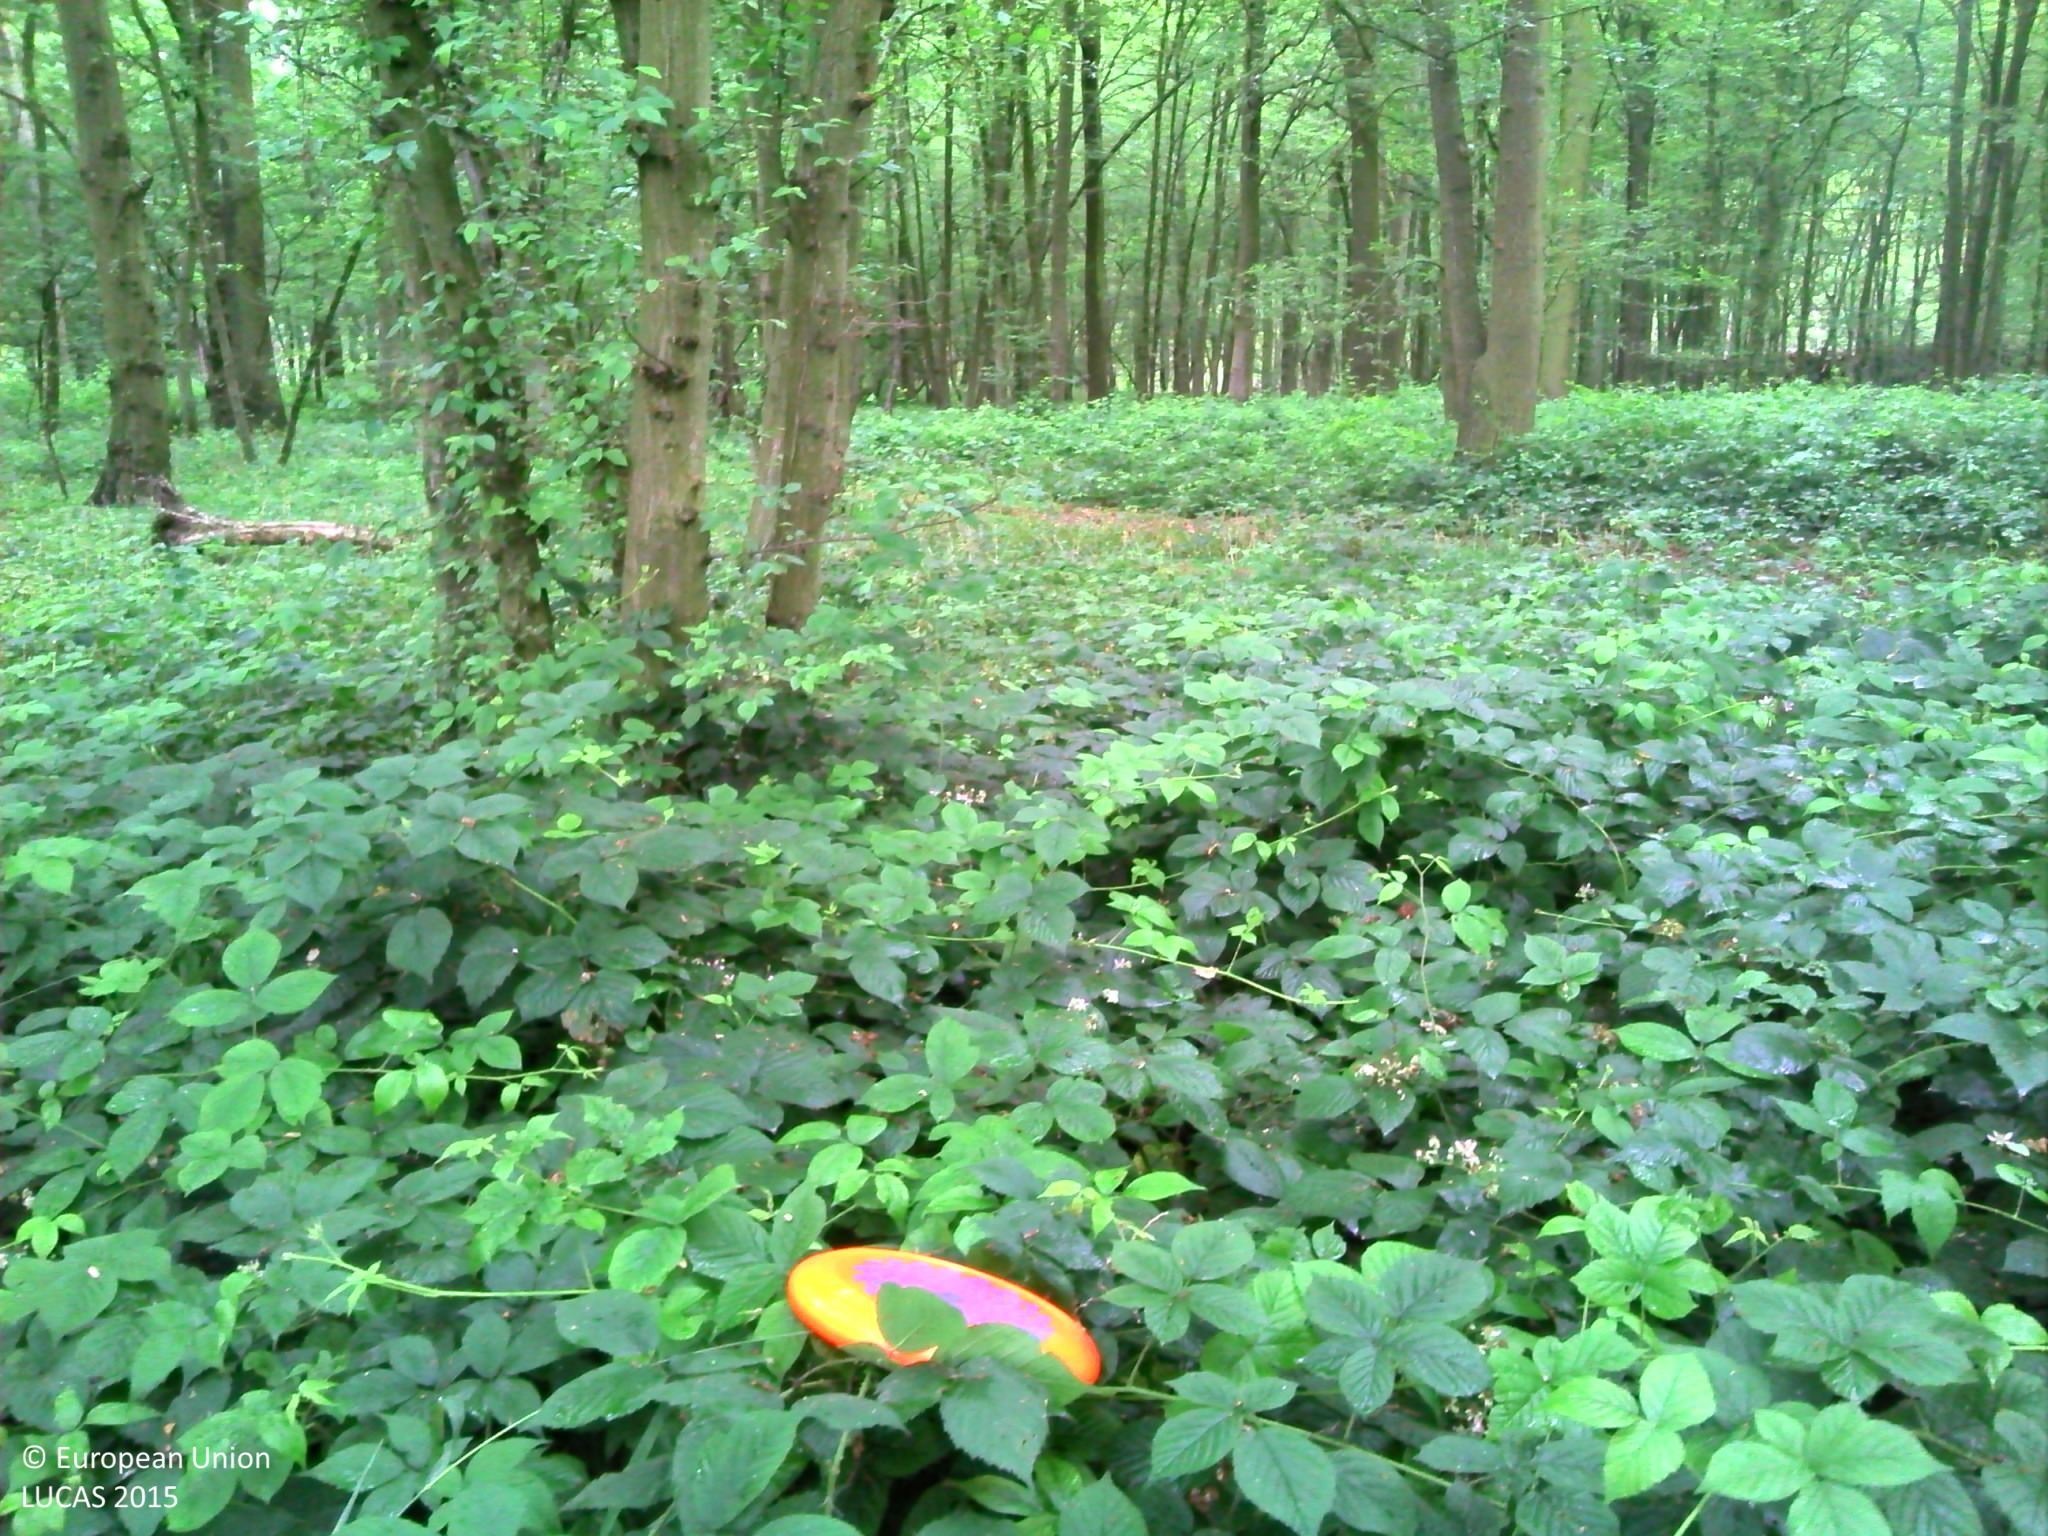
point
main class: Woodland
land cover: Broadleaved woodland
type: acidophilous oak and oak-birch forest
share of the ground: > 75 %
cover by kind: broadleaved forest trees 80 %, herbaceous plants 15 %, lichens and mosses 5 %
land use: Forestry
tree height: > 5 m
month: July
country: FR
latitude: 50.4966
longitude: 3.0686
